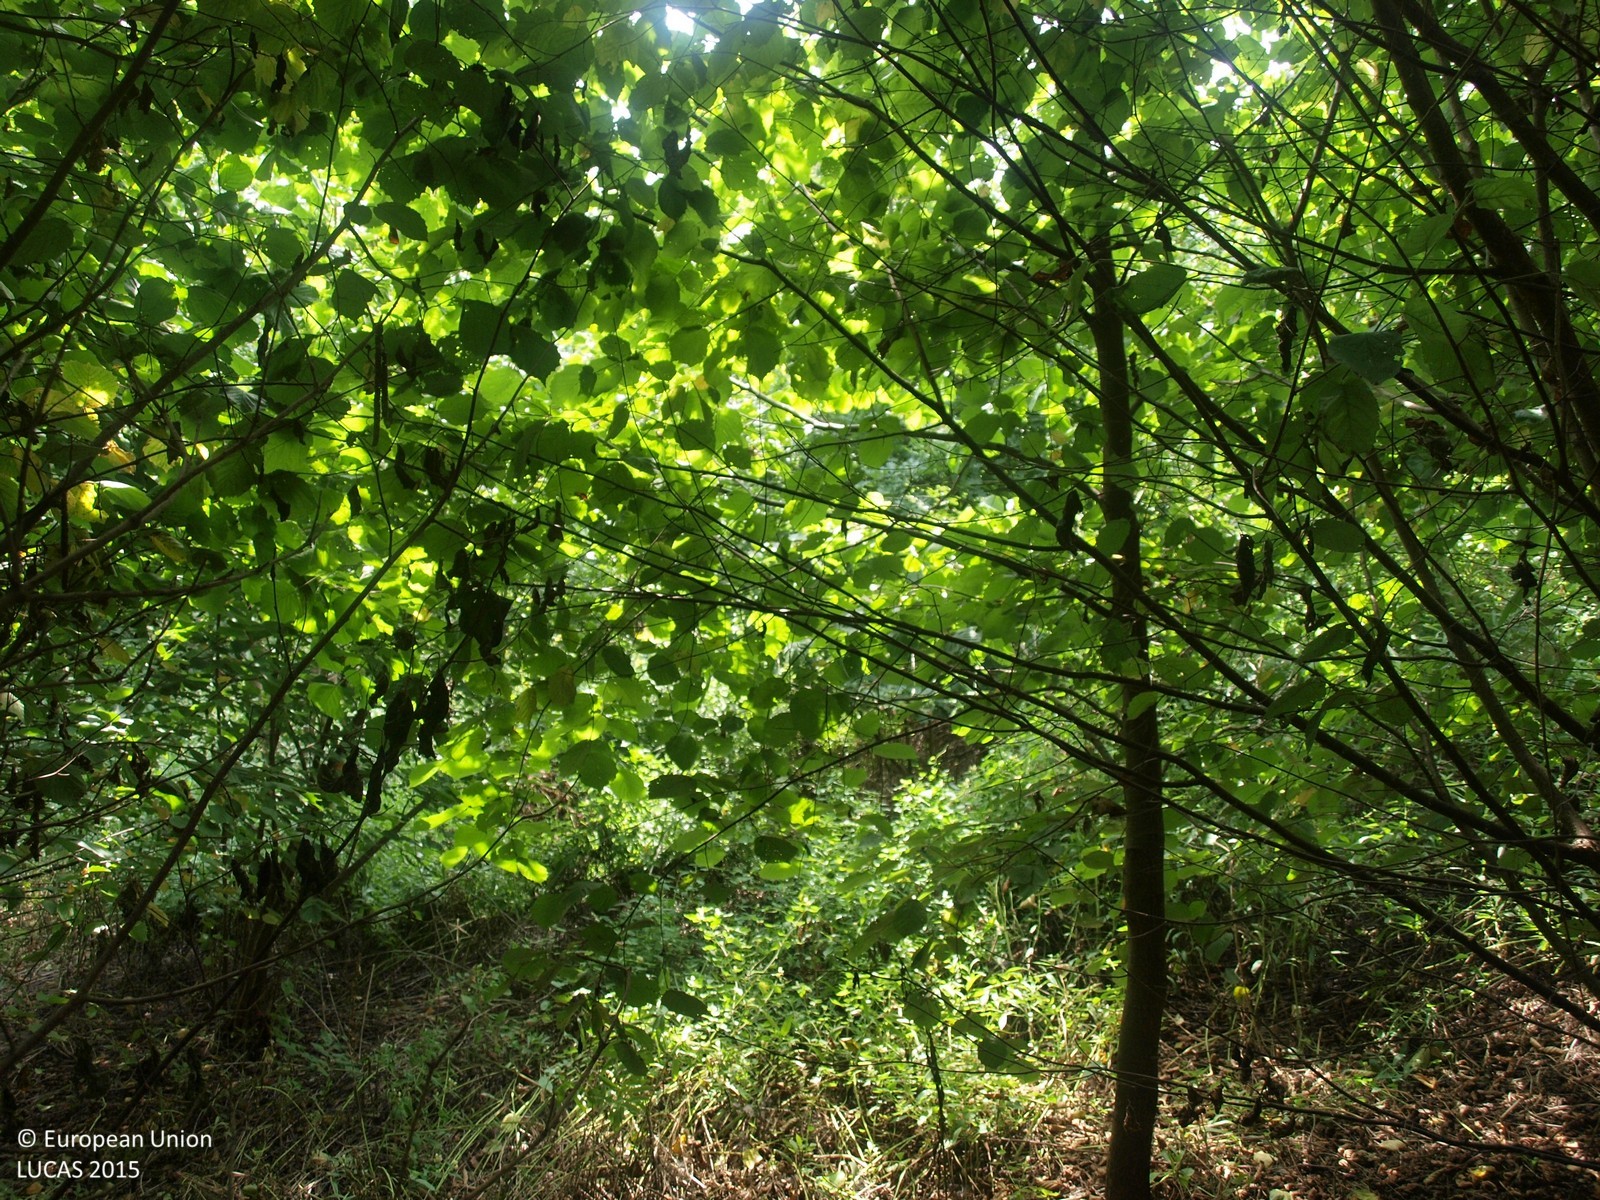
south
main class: Shrubland
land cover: Shrubland with sparse tree cover
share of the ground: > 75 %
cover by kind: shrubs 95 %, broadleaved forest trees 5 %
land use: Forestry
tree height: < 5 m
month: August
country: HR
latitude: 46.0887
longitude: 16.3757
